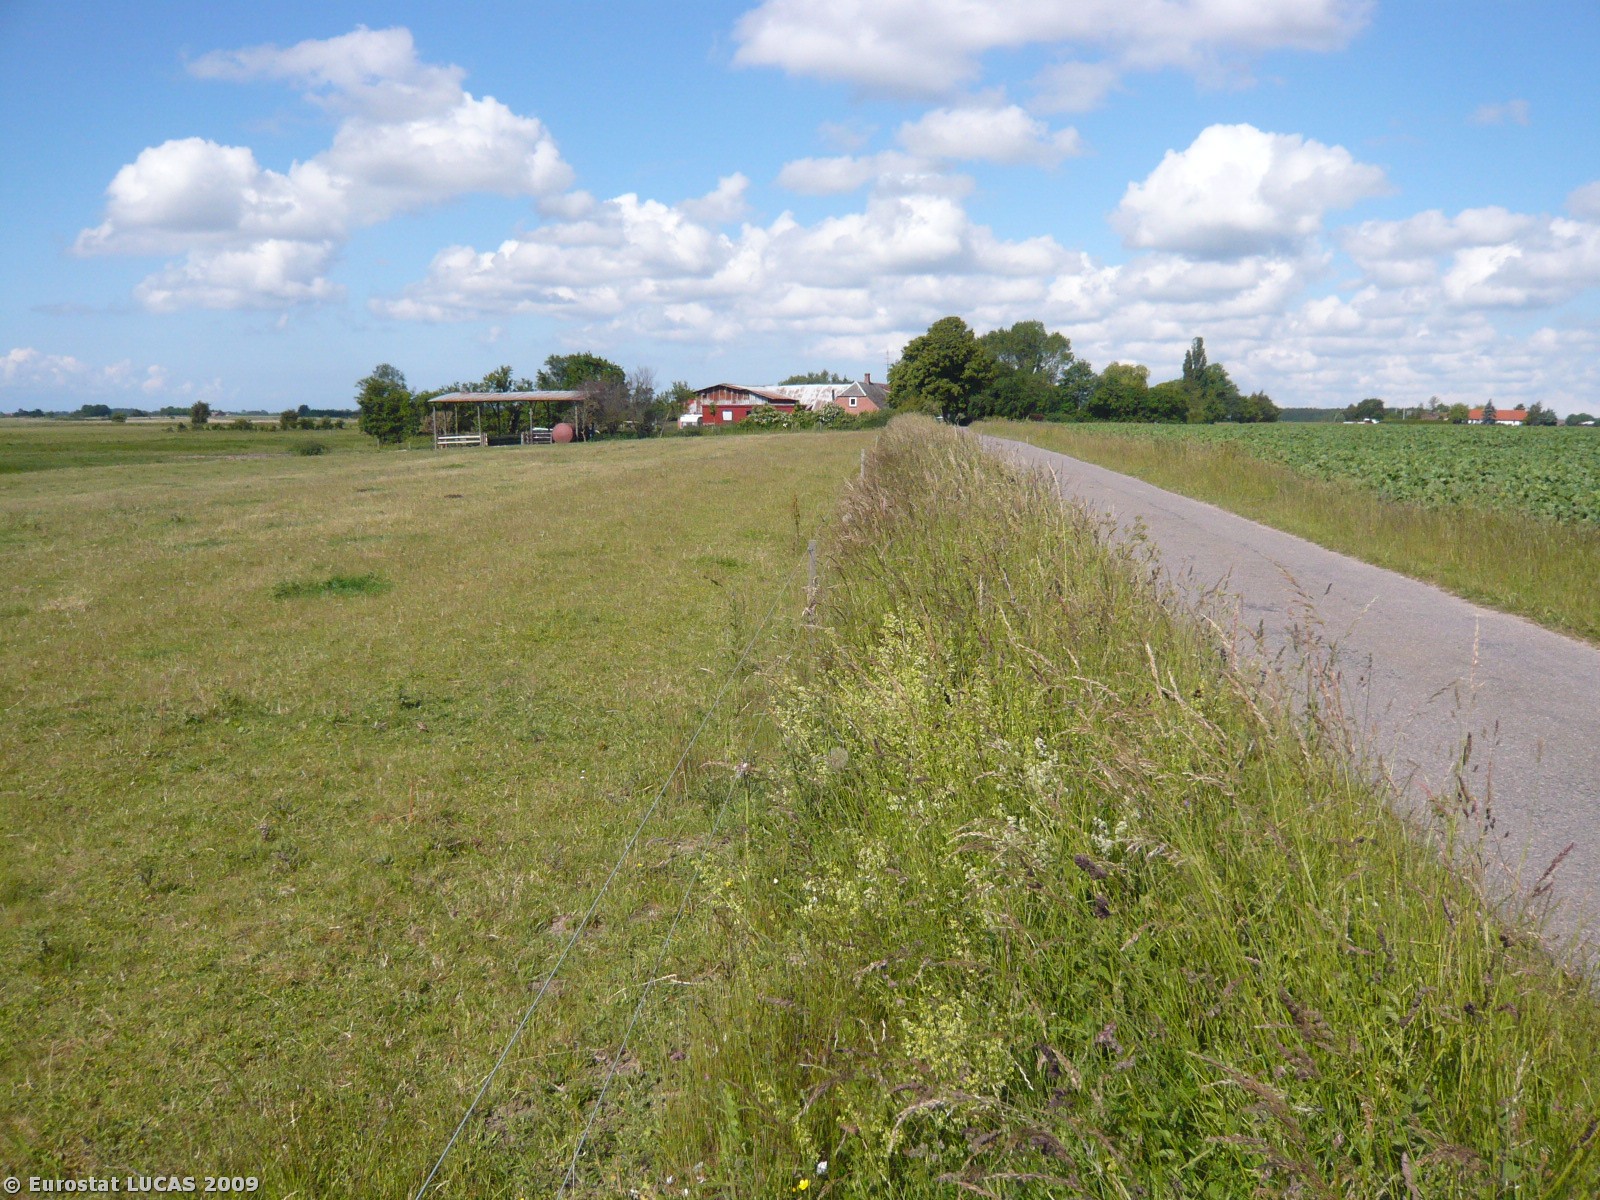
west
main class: Grassland
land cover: Grassland without tree/shrub cover
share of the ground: > 75 %
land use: Agriculture (excluding fallow land and kitchen gardens)
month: June
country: DK
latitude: 54.6677
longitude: 11.5960
